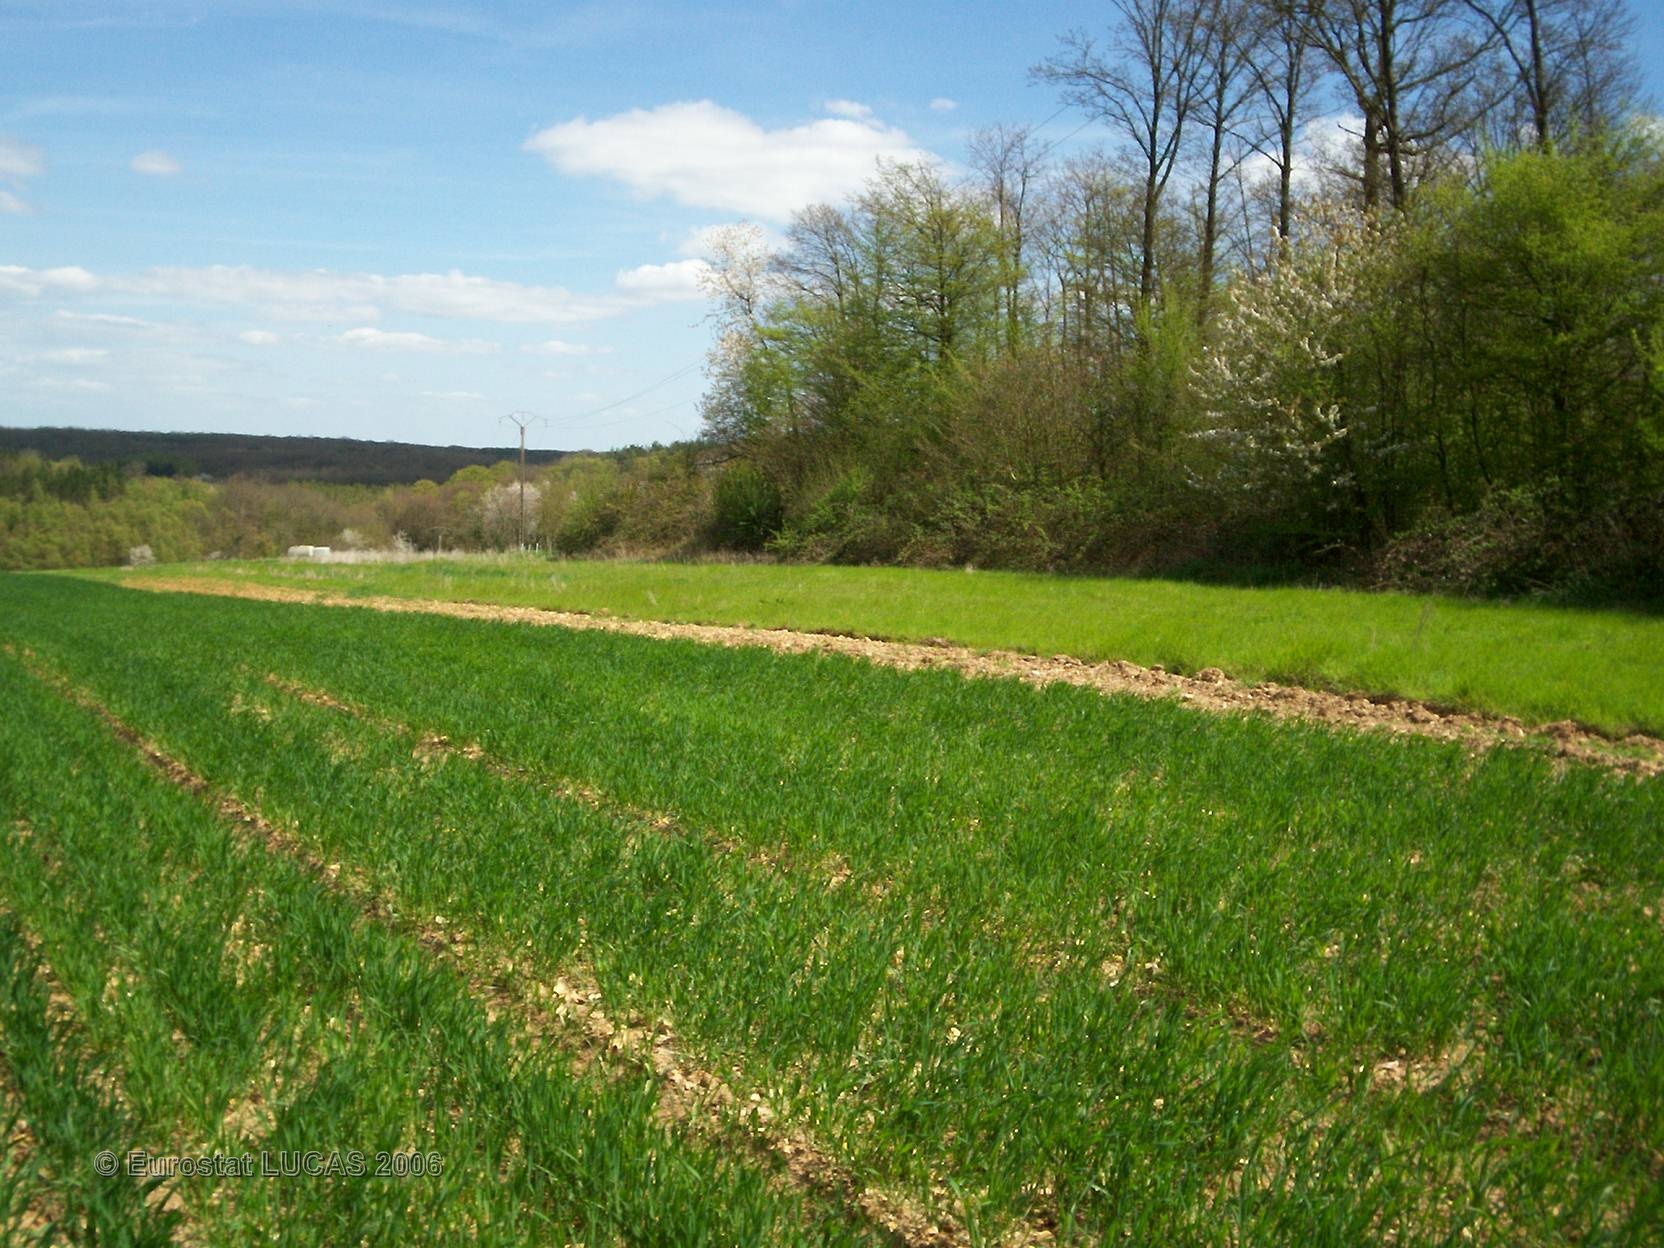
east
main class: Cropland
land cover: Common wheat
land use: Agriculture (excluding fallow land and kitchen gardens)
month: April
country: FR
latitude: 48.9438
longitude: 1.0358
